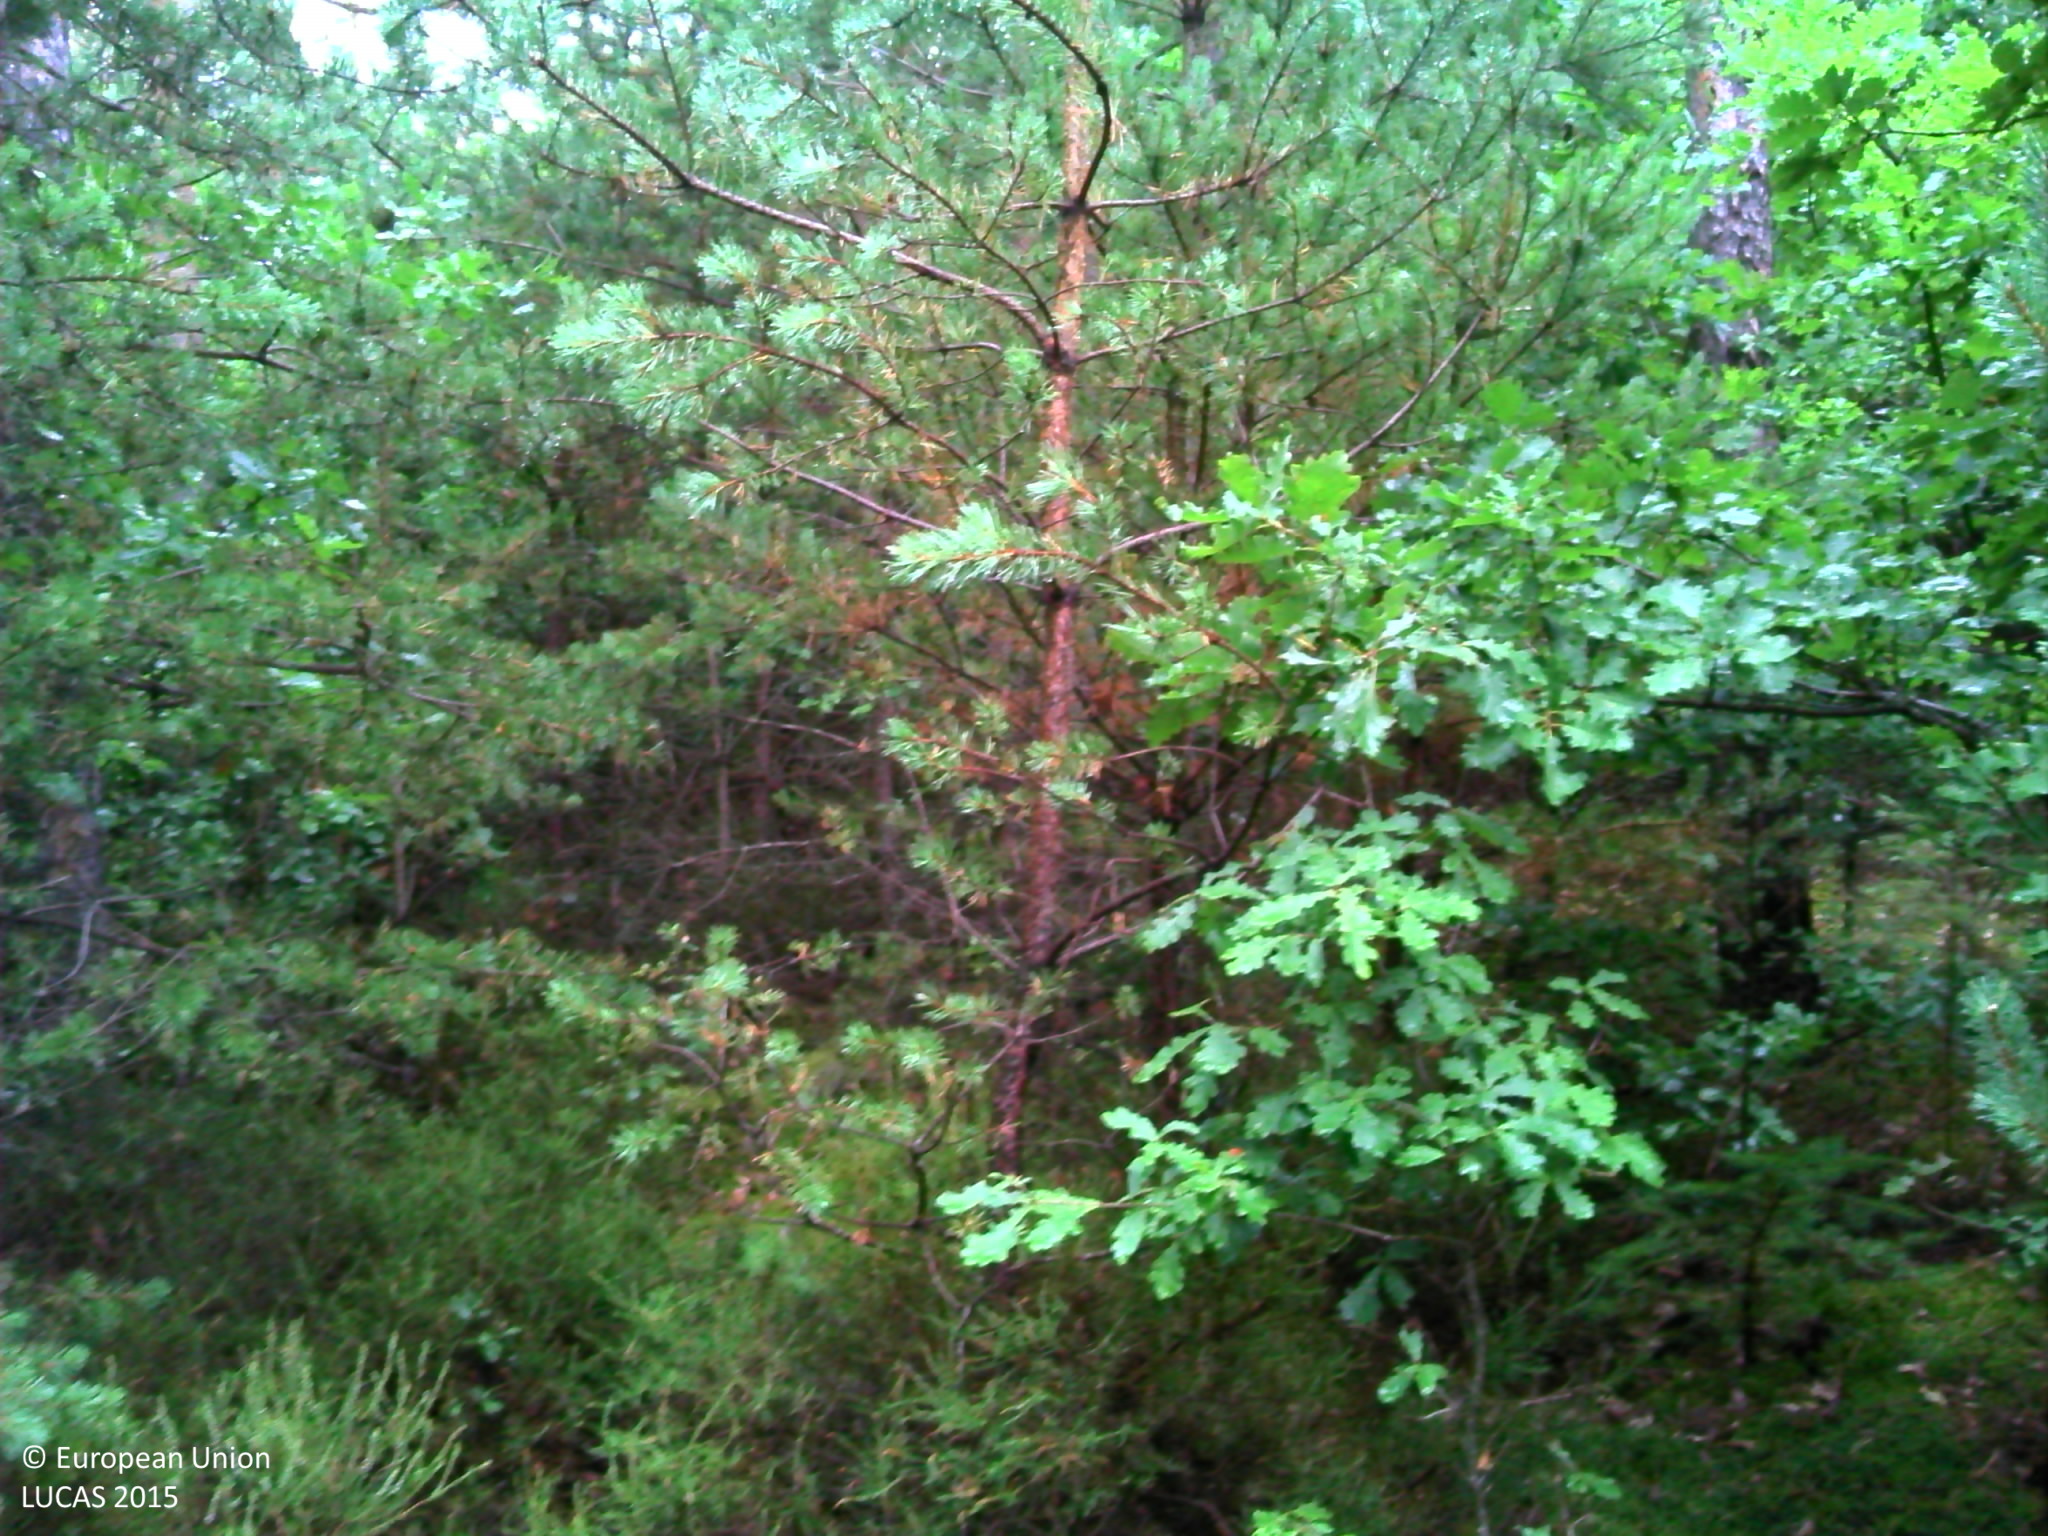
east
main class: Woodland
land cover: Broadleaved woodland
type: thermophilous deciduous forest
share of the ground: > 75 %
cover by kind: broadleaved forest trees 65 %, coniferous forest trees 10 %, shrubs 10 %, lichens and mosses 10 %, herbaceous plants 5 %
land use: Forestry
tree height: > 5 m
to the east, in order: Pine dominated mixed woodland; Arable land (only in case pi); Pine dominated mixed woodland; Fences; Tracks; Fences; Grassland without tree/shrub cover
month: July
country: FR
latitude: 45.4691
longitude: 4.1580
